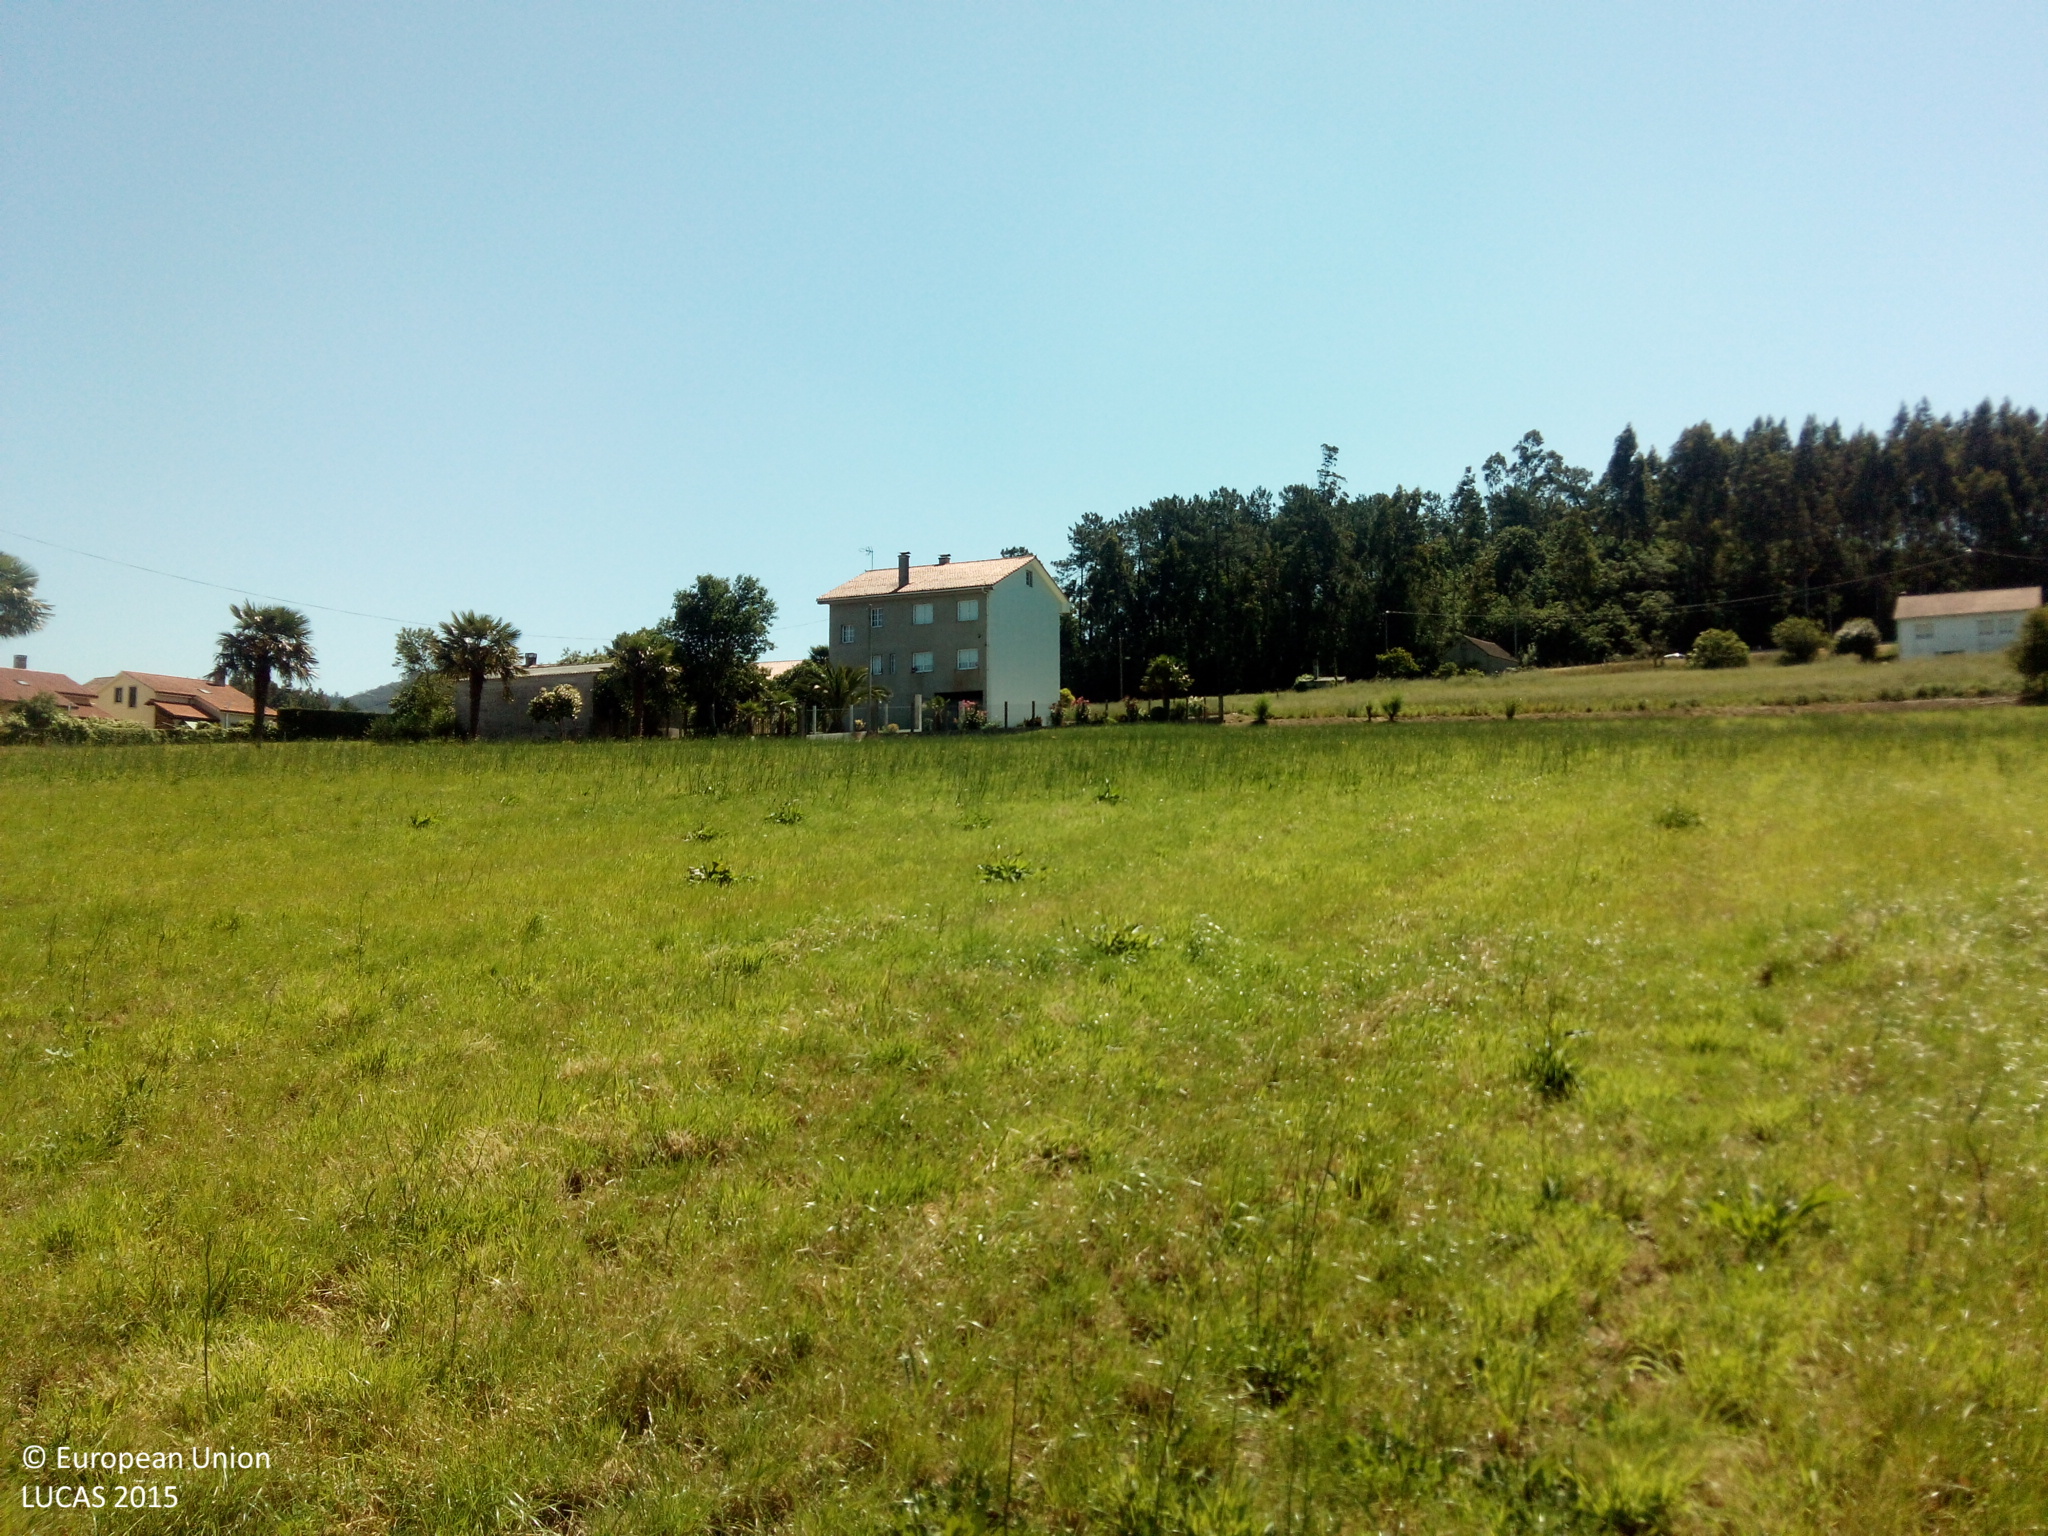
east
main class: Grassland
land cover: Grassland without tree/shrub cover
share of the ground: > 75 %
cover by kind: herbaceous plants 100 %
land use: Agriculture (excluding fallow land and kitchen gardens)
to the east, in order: Grassland without tree/shrub cover; Artificial constructions in urban areas; Spontaneously vegetated surfaces; Fences; Other fruit trees and berries; Fences; Spontaneously vegetated surfaces; Electric lines; Paved roads, cycling and walking lanes; Ditches and canals; Paved roads, cycling and walking lanes; Ditches and canals; Artificial constructions; Tracks; Broadleaved woodland; Maize
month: May
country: ES
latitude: 42.8021
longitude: -8.4797
